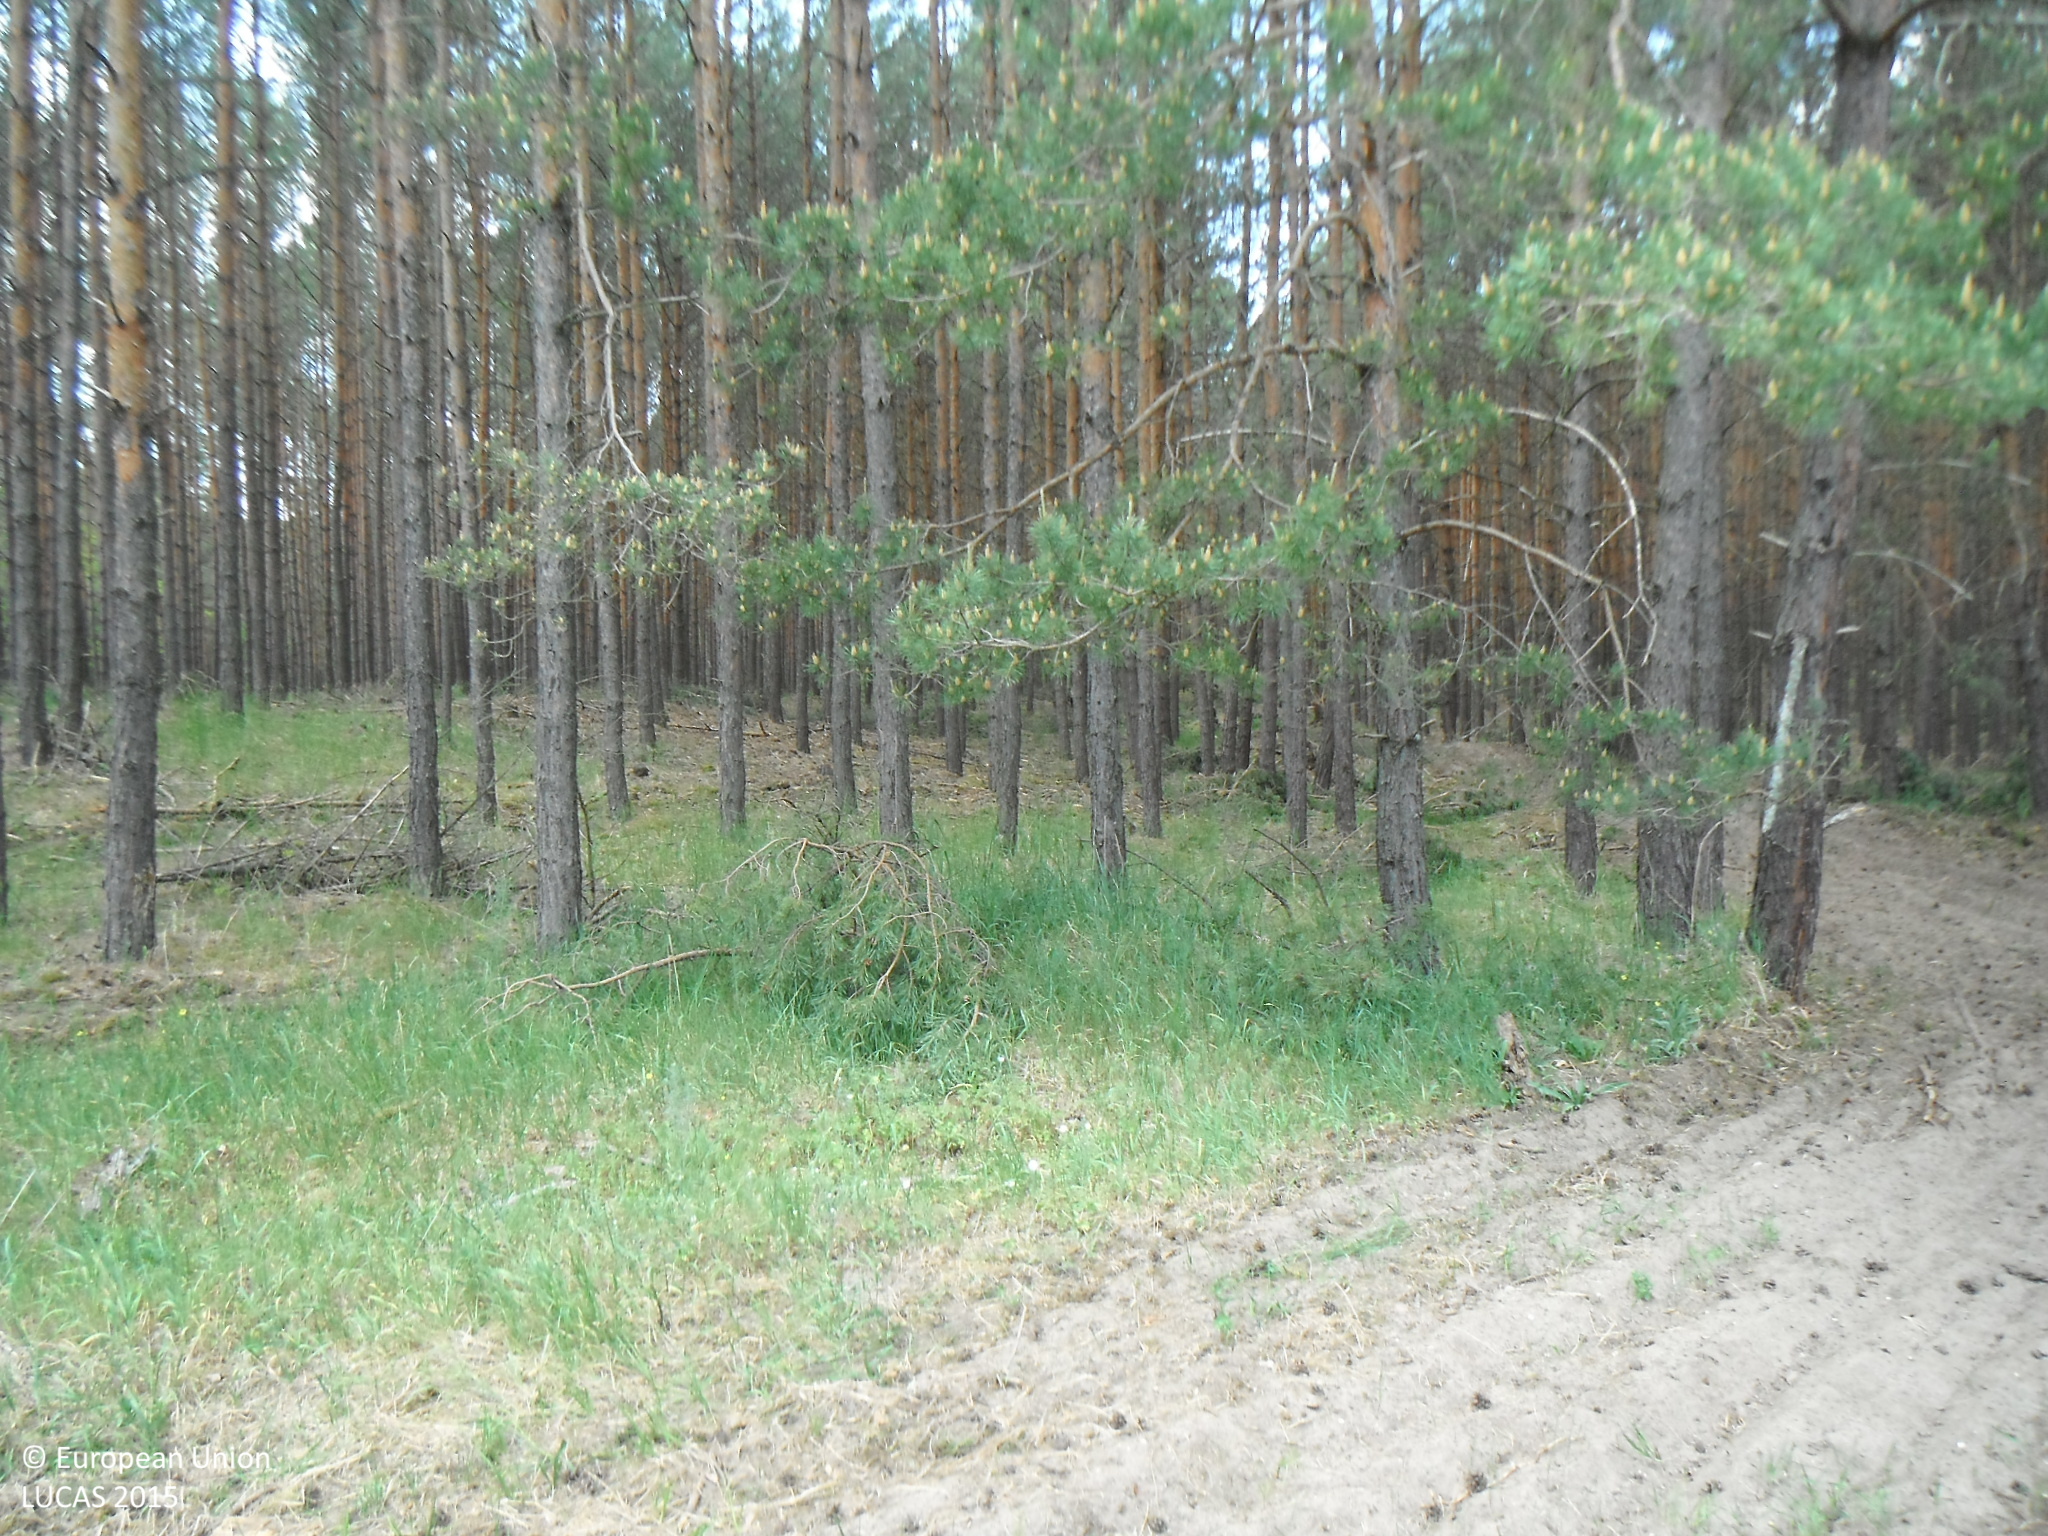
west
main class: Grassland
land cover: Spontaneously vegetated surfaces
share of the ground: 50 - 75 %
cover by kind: herbaceous plants 70 %, unconsolidated bare surface 30 %
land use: Forestry
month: May
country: SK
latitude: 48.5548
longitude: 17.0944
